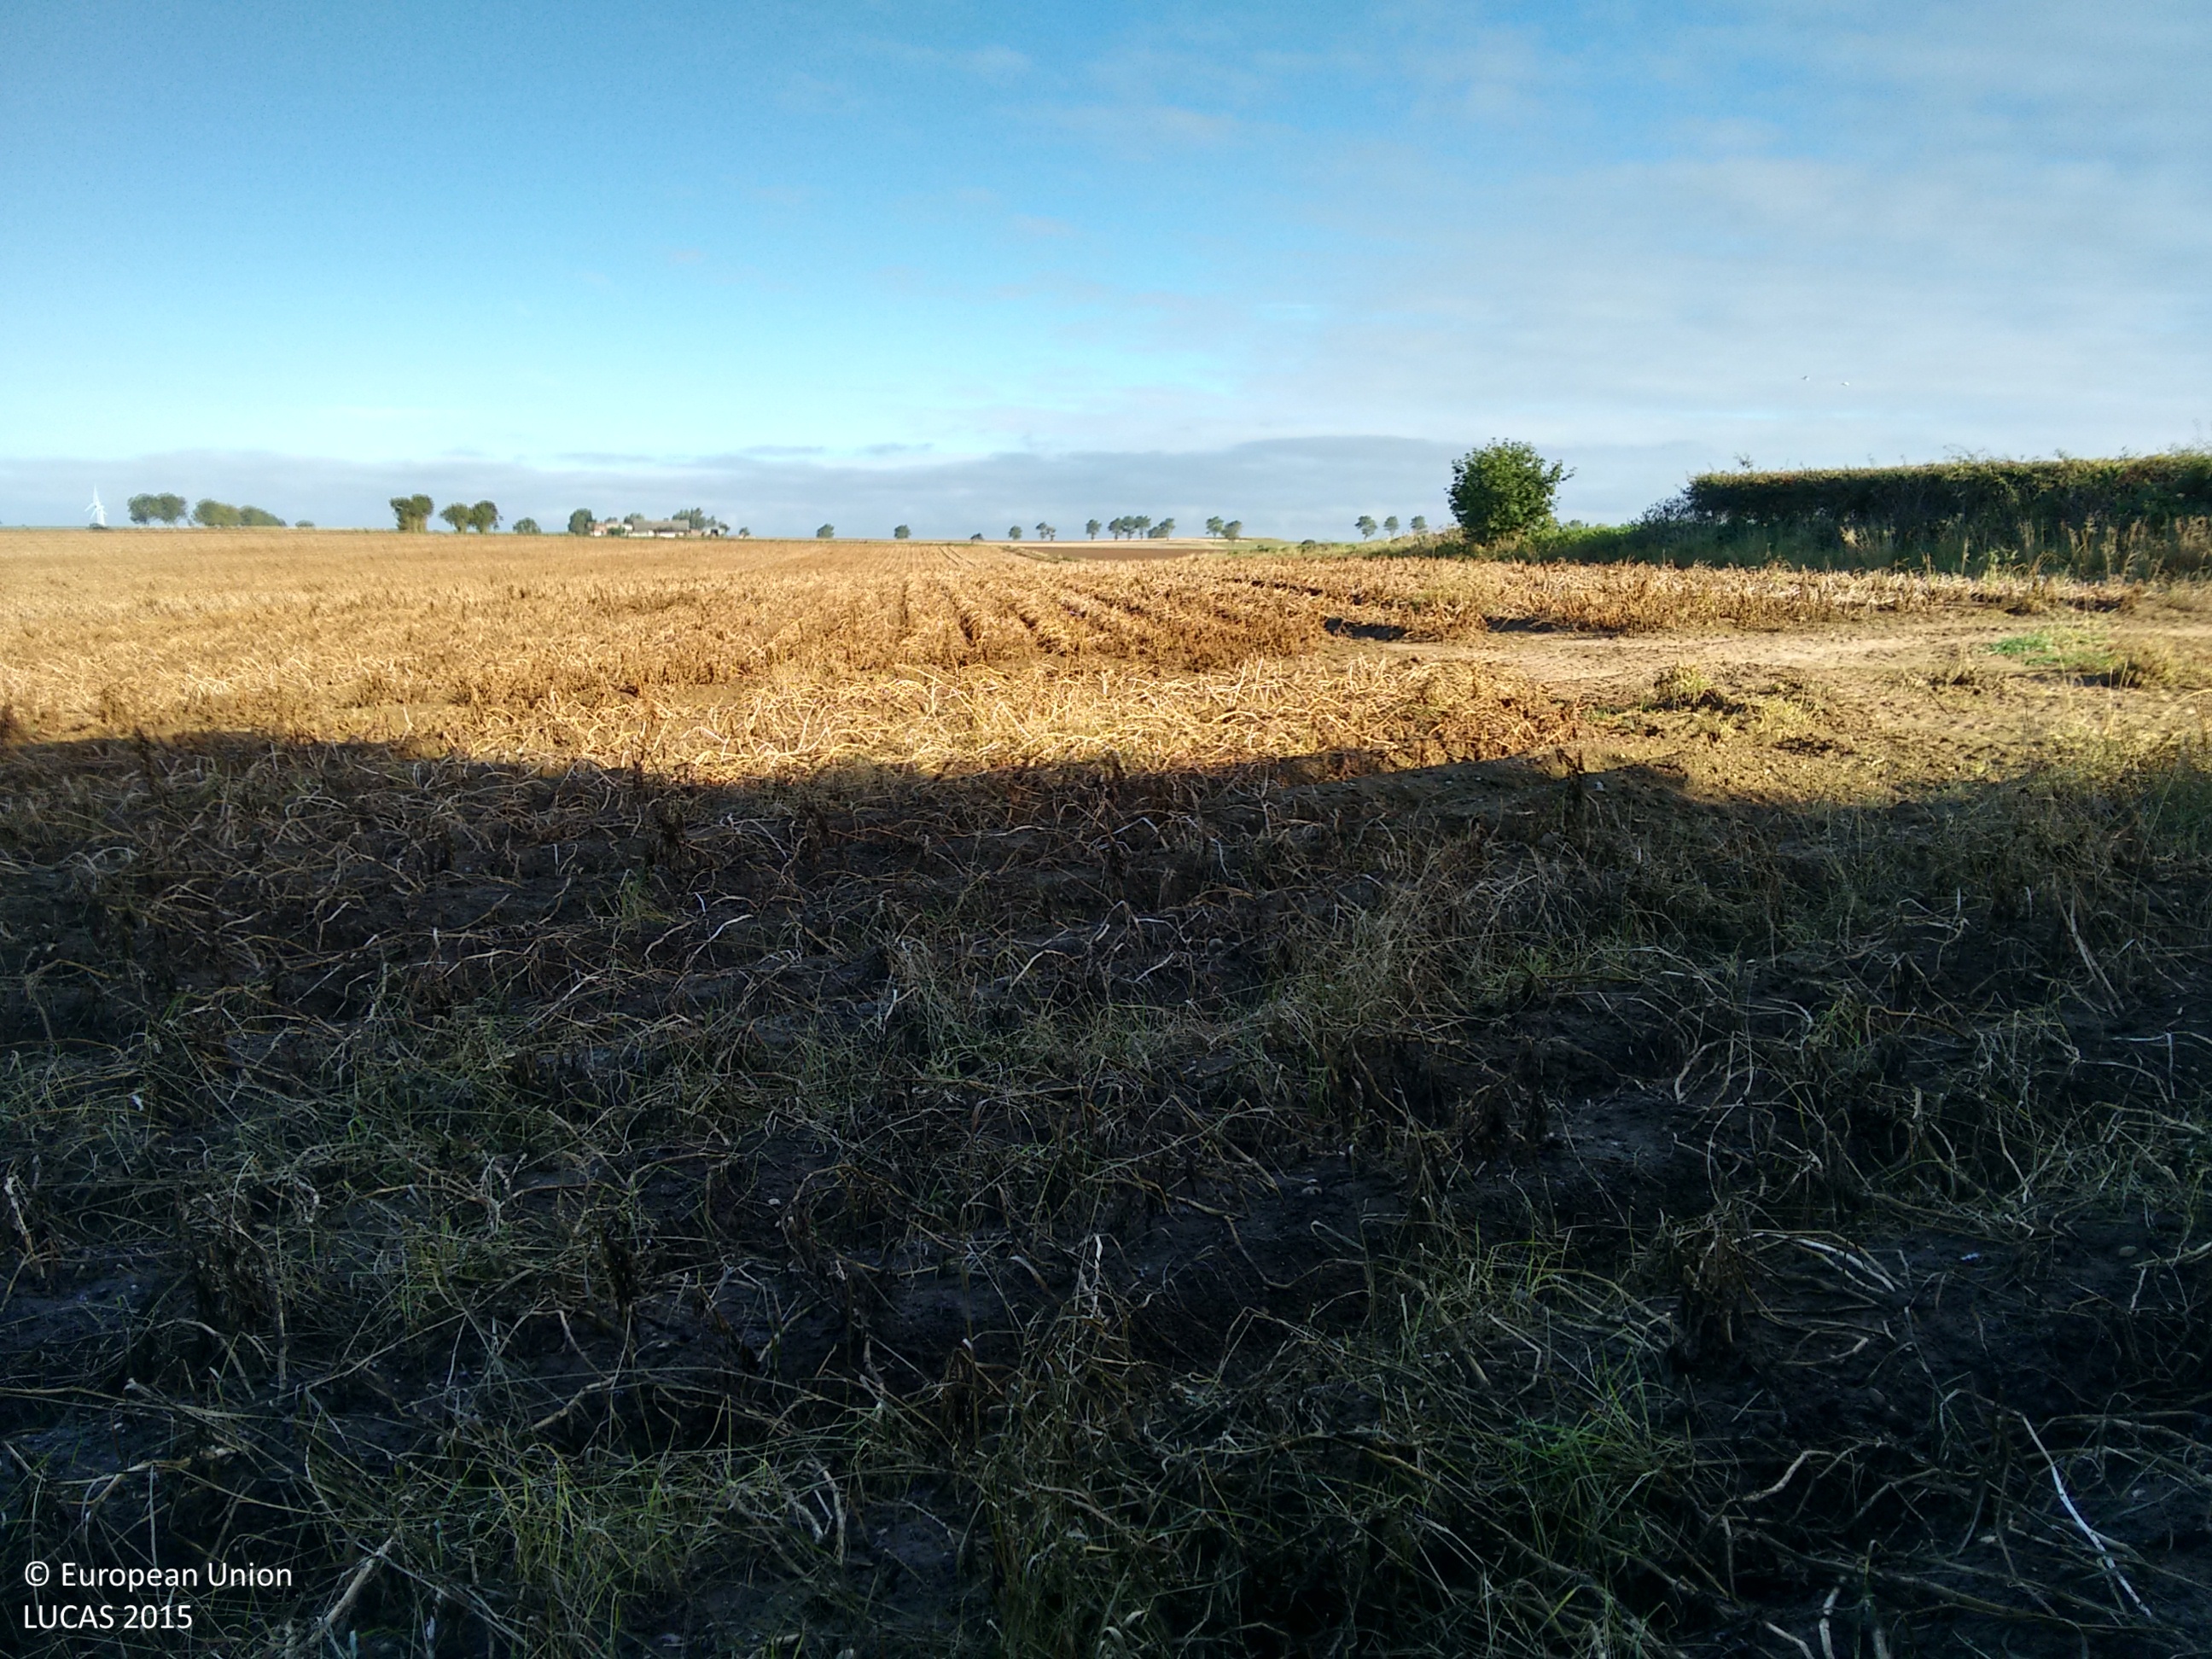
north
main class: Cropland
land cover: Common wheat
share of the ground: > 75 %
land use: Agriculture (excluding fallow land and kitchen gardens)
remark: Harvested field
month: October
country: GB
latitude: 52.6997
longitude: 1.6807
